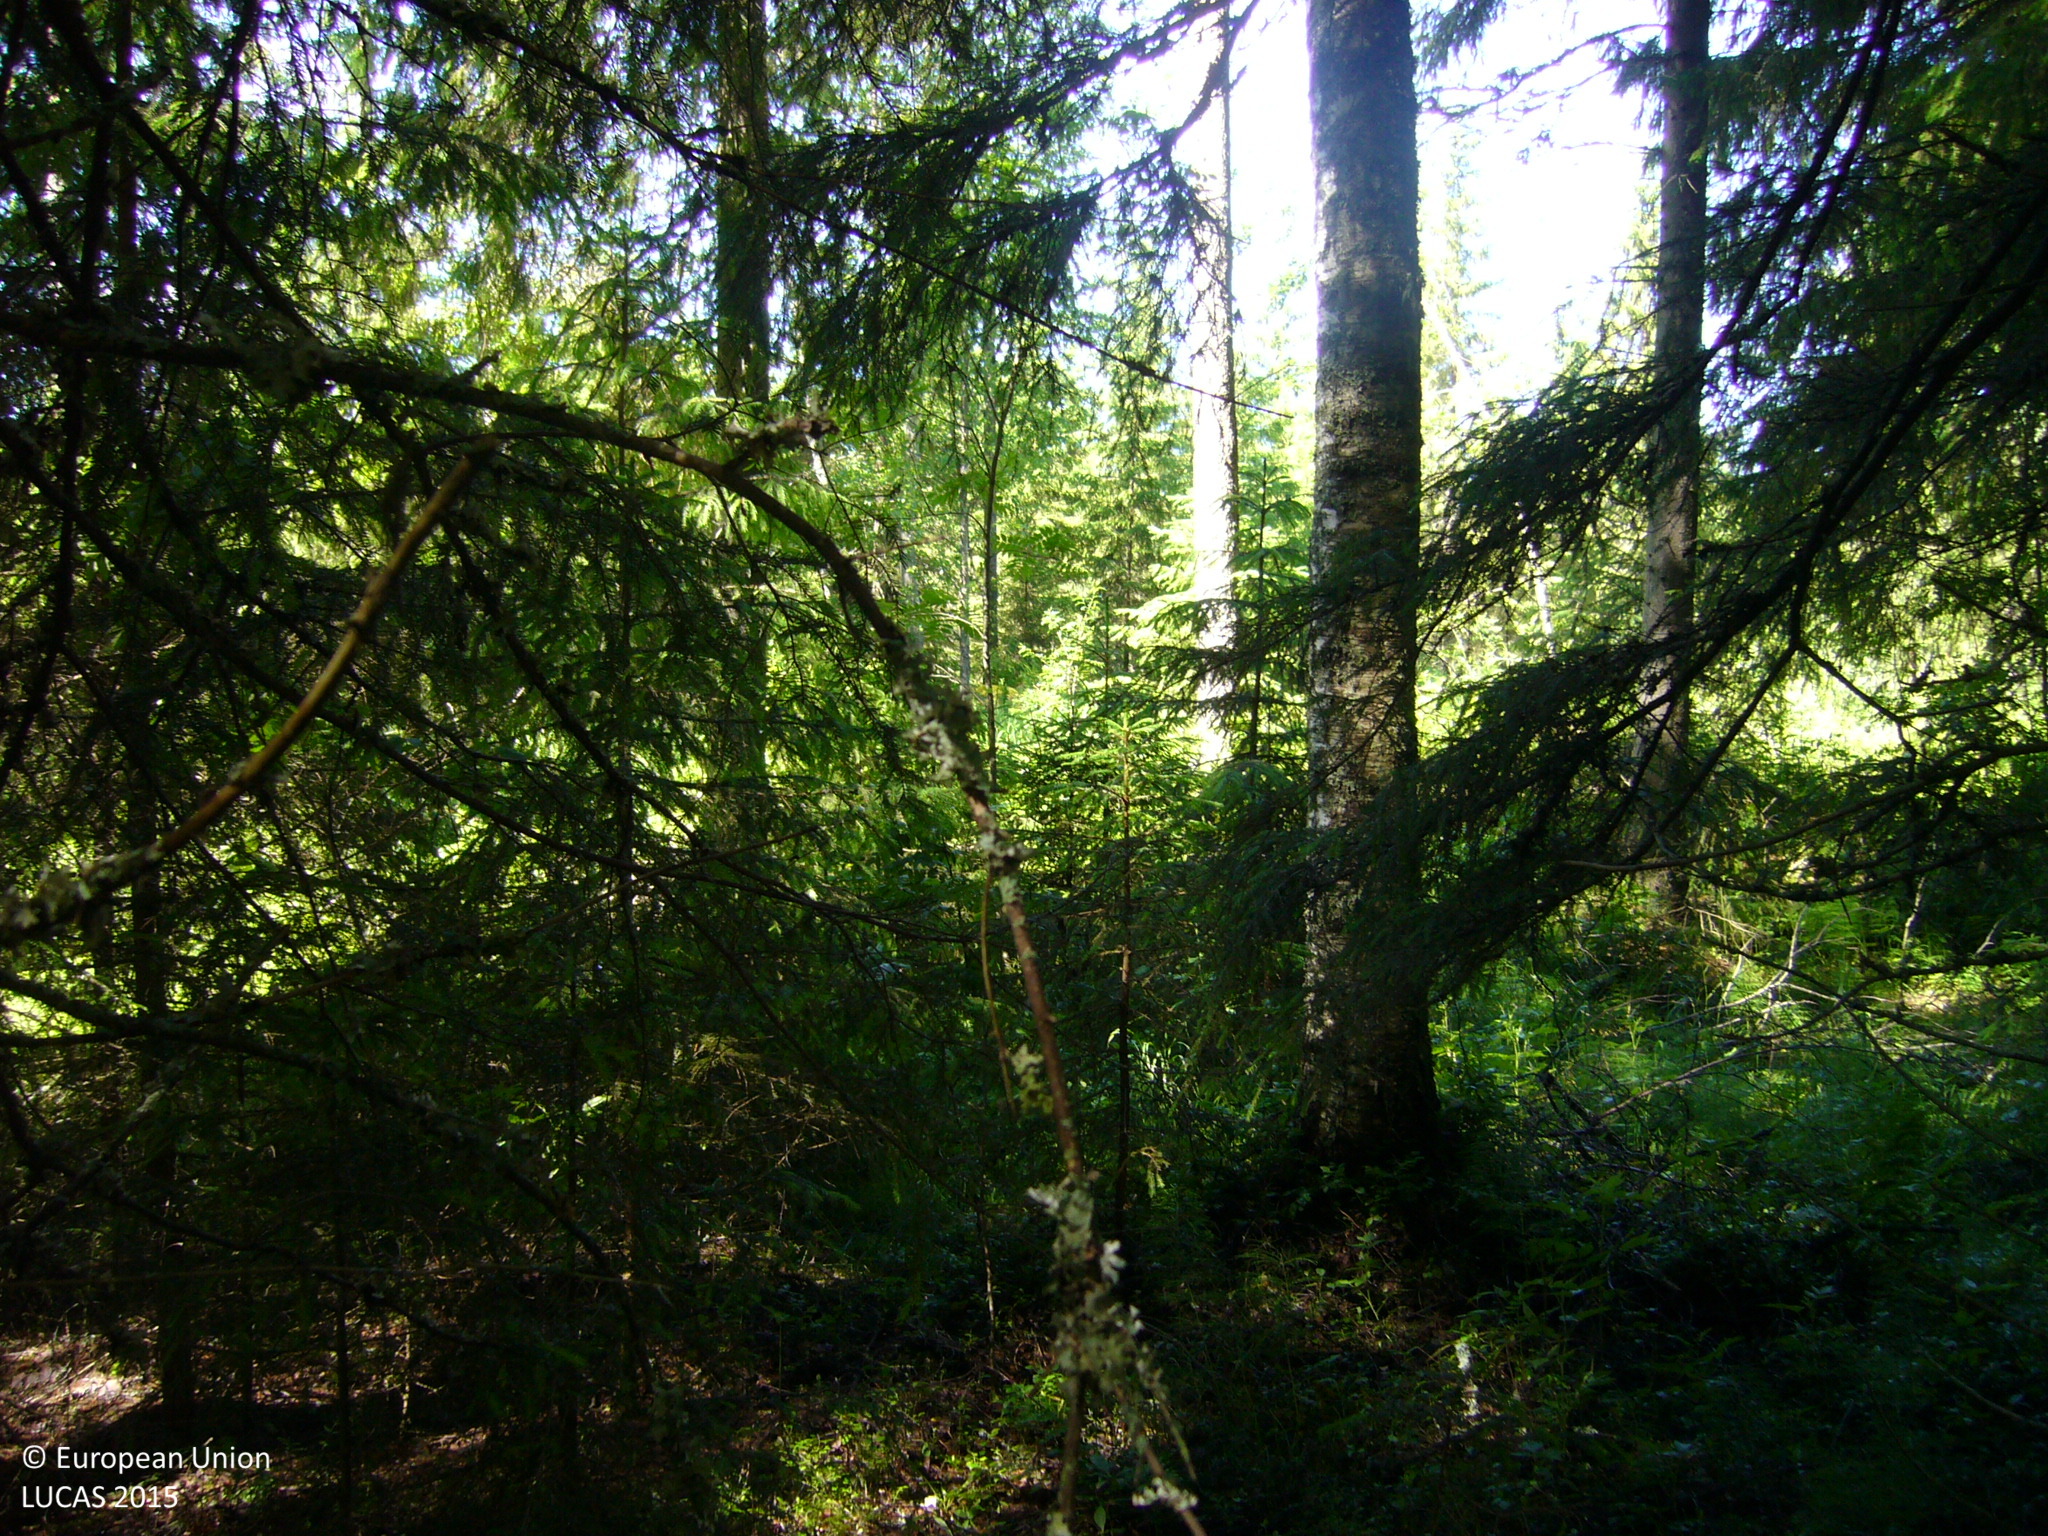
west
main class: Woodland
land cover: Spruce dominated coniferous woodland
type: boreal forest
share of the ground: > 75 %
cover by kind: coniferous forest trees 90 %, shrubs 5 %, herbaceous plants 5 %
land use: Forestry
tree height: > 5 m
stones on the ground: < 10 %
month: July
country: FI
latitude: 63.5489
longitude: 26.2783
